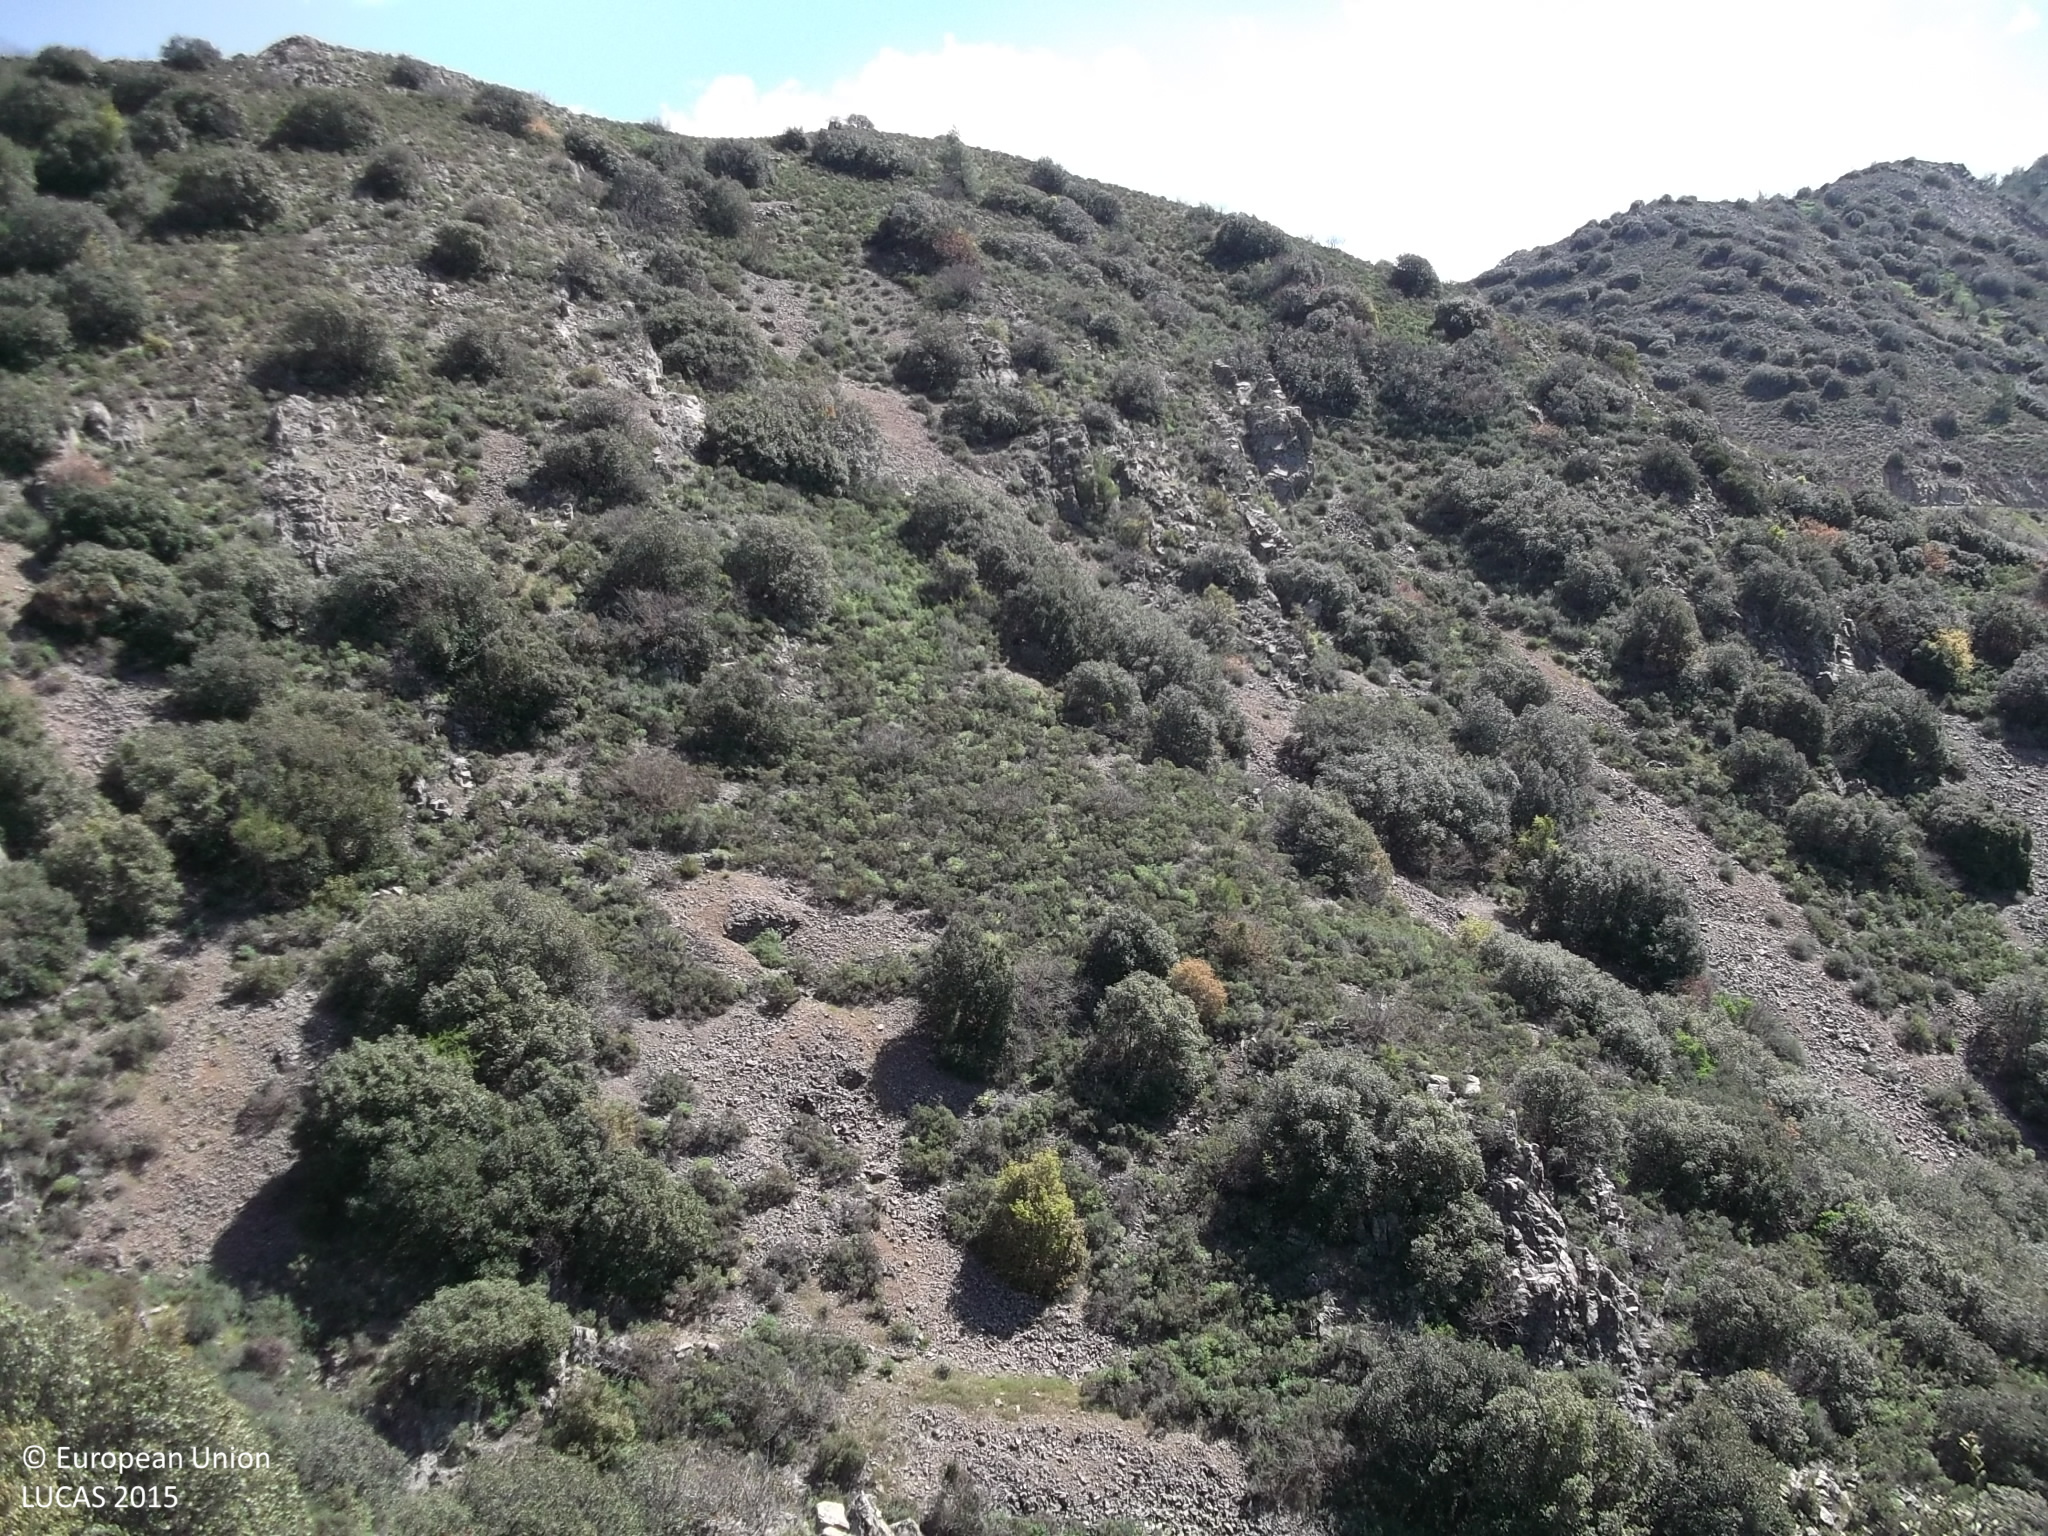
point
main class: Woodland
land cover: Broadleaved woodland
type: broadleaved evergreen forest
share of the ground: 25 - 50 %
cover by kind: broadleaved forest trees 45 %, shrubs 25 %, herbaceous plants 10 %, consolidated bare surface 10 %, unconsolidated bare surface 10 %
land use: Semi-natural and natural areas not in use
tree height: > 5 m
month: April
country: CY
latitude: 34.8994
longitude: 33.1008
